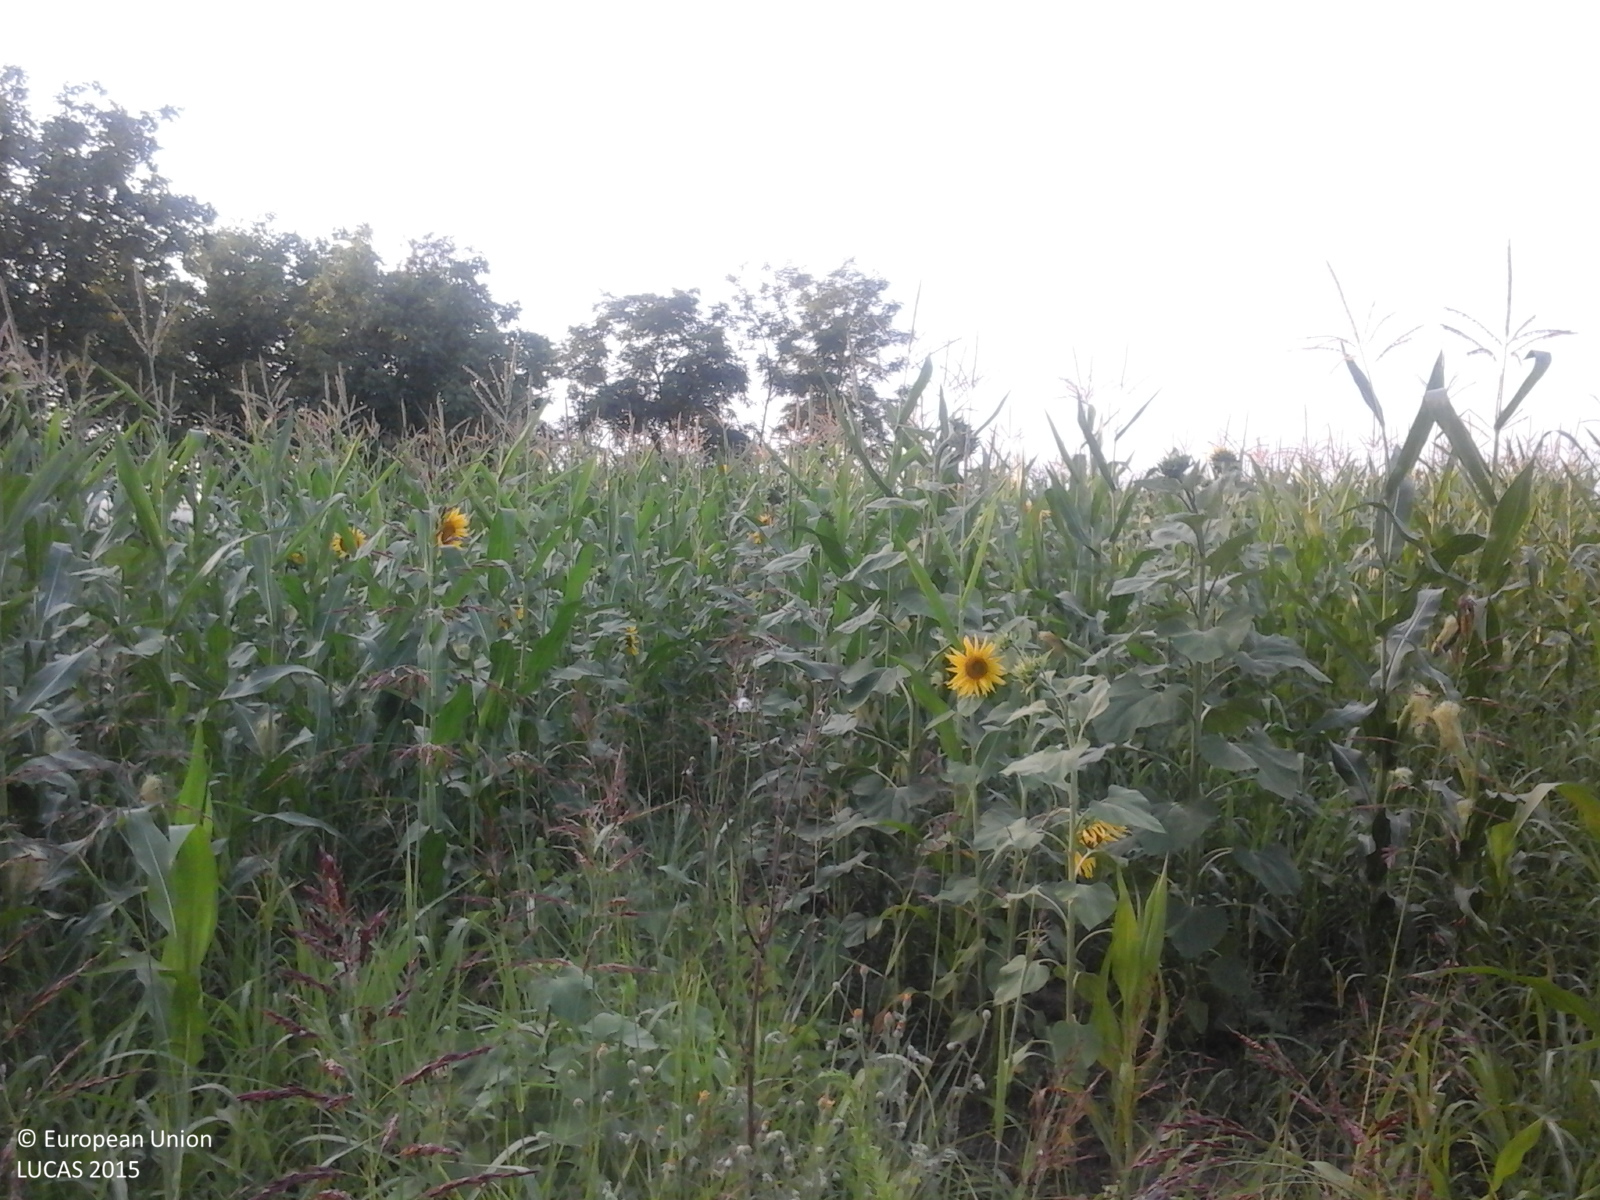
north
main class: Cropland
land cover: Maize
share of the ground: > 75 %
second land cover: Sunflower
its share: > 75 %
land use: Agriculture (excluding fallow land and kitchen gardens)
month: July
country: RO
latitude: 43.8635
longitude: 25.4507
